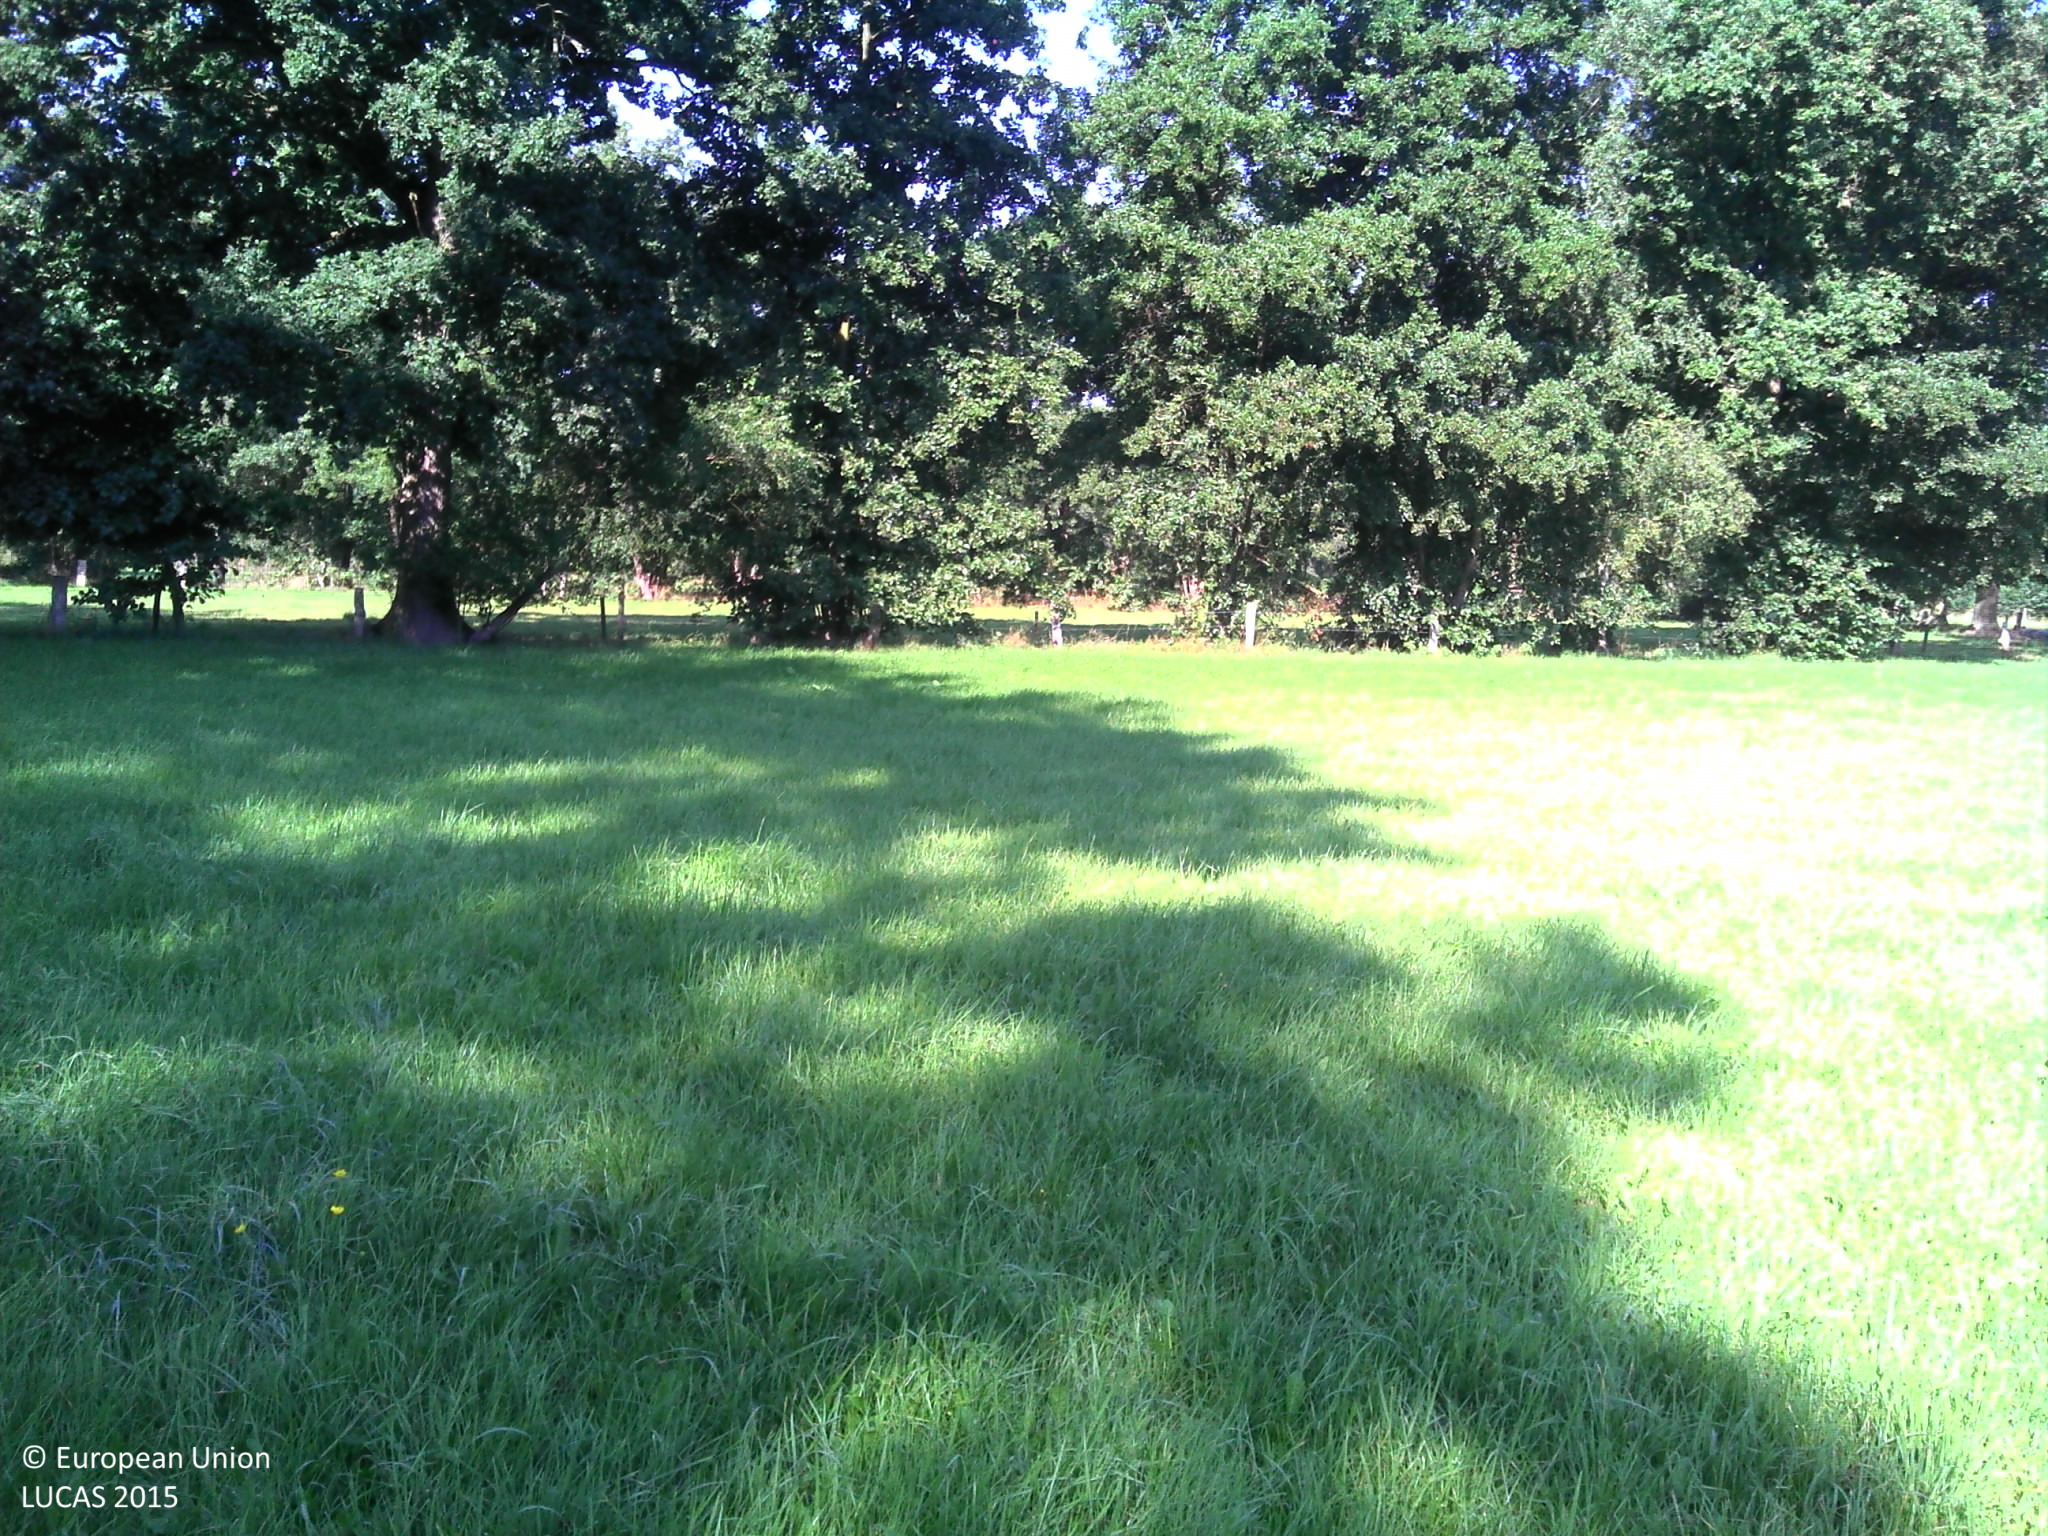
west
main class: Grassland
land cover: Grassland without tree/shrub cover
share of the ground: > 75 %
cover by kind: herbaceous plants 100 %
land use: Agriculture (excluding fallow land and kitchen gardens)
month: August
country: BE
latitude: 51.1654
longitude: 5.2355
